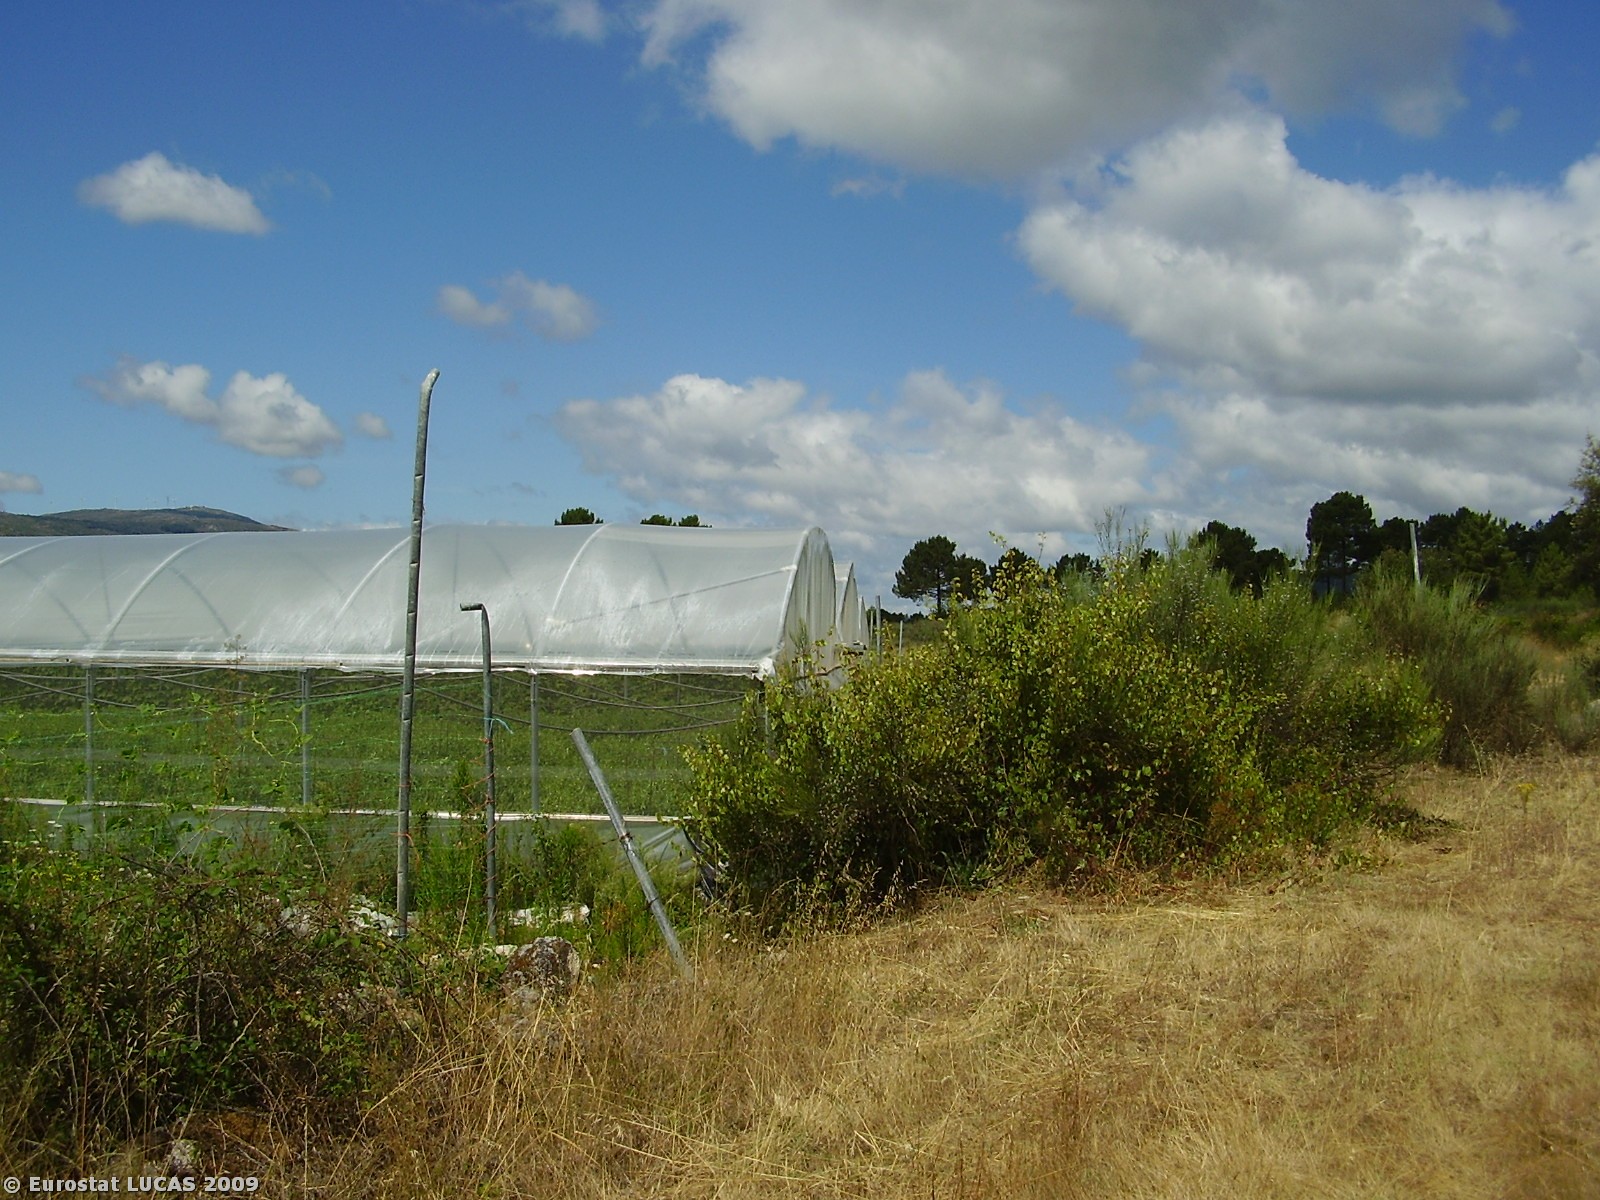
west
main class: Grassland
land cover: Spontaneously vegetated surfaces
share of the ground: > 75 %
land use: Fallow land
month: July
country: PT
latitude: 41.5636
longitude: -7.5775
